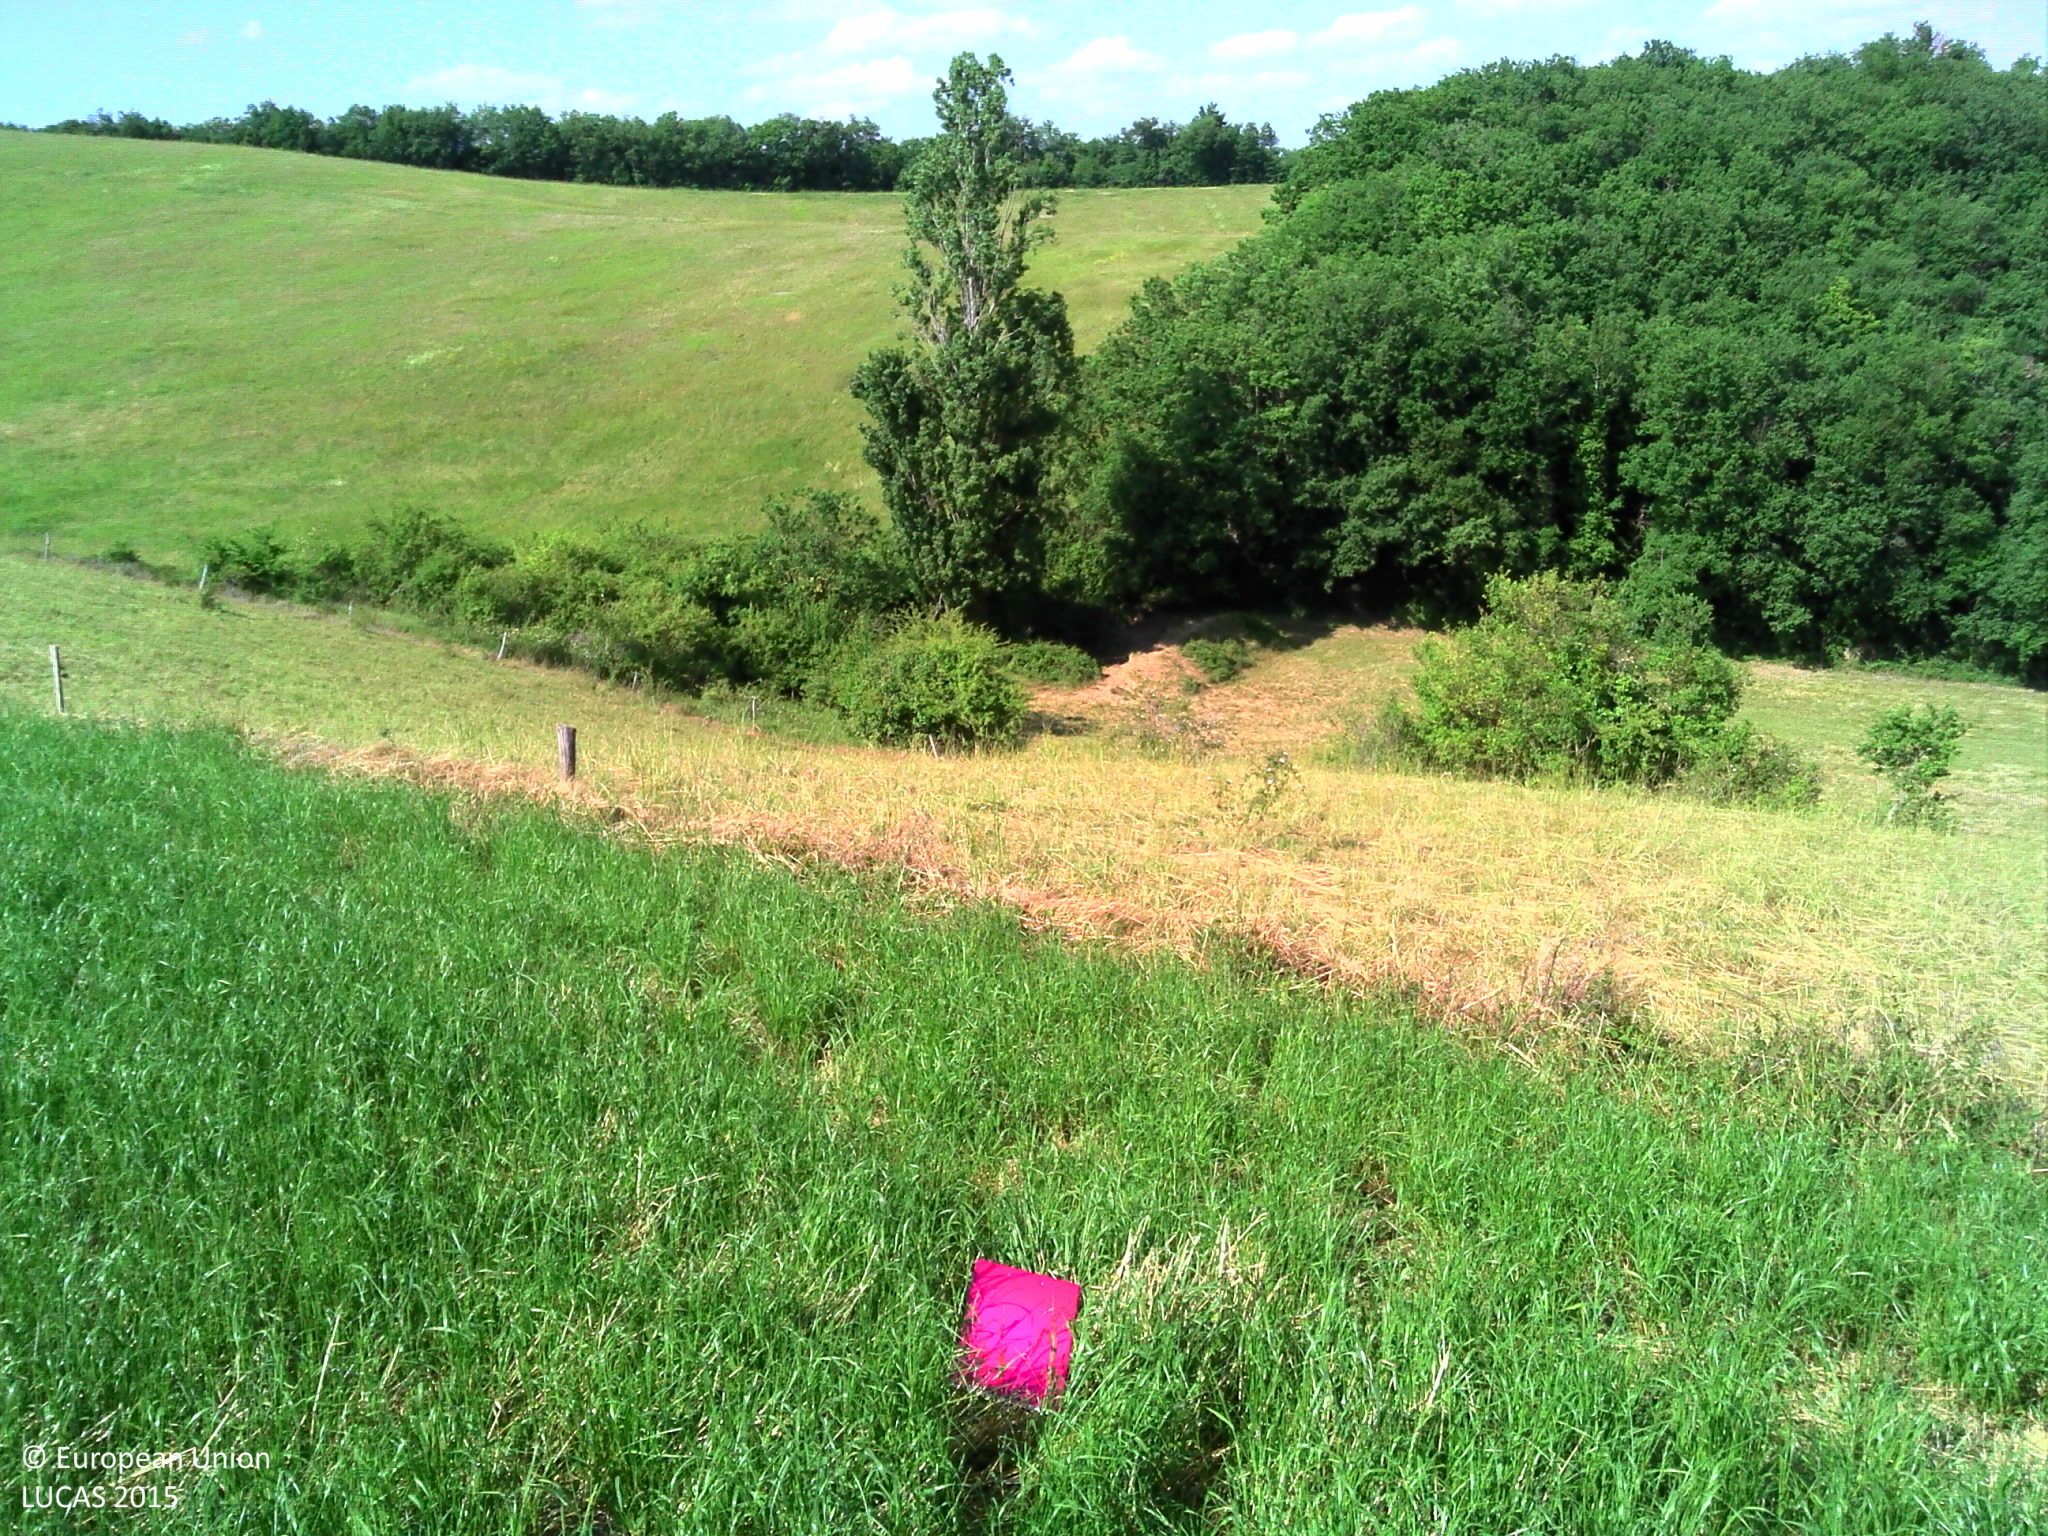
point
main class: Cropland
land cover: Temporary grasslands
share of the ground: > 75 %
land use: Agriculture (excluding fallow land and kitchen gardens)
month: June
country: FR
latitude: 43.4976
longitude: 0.7117
